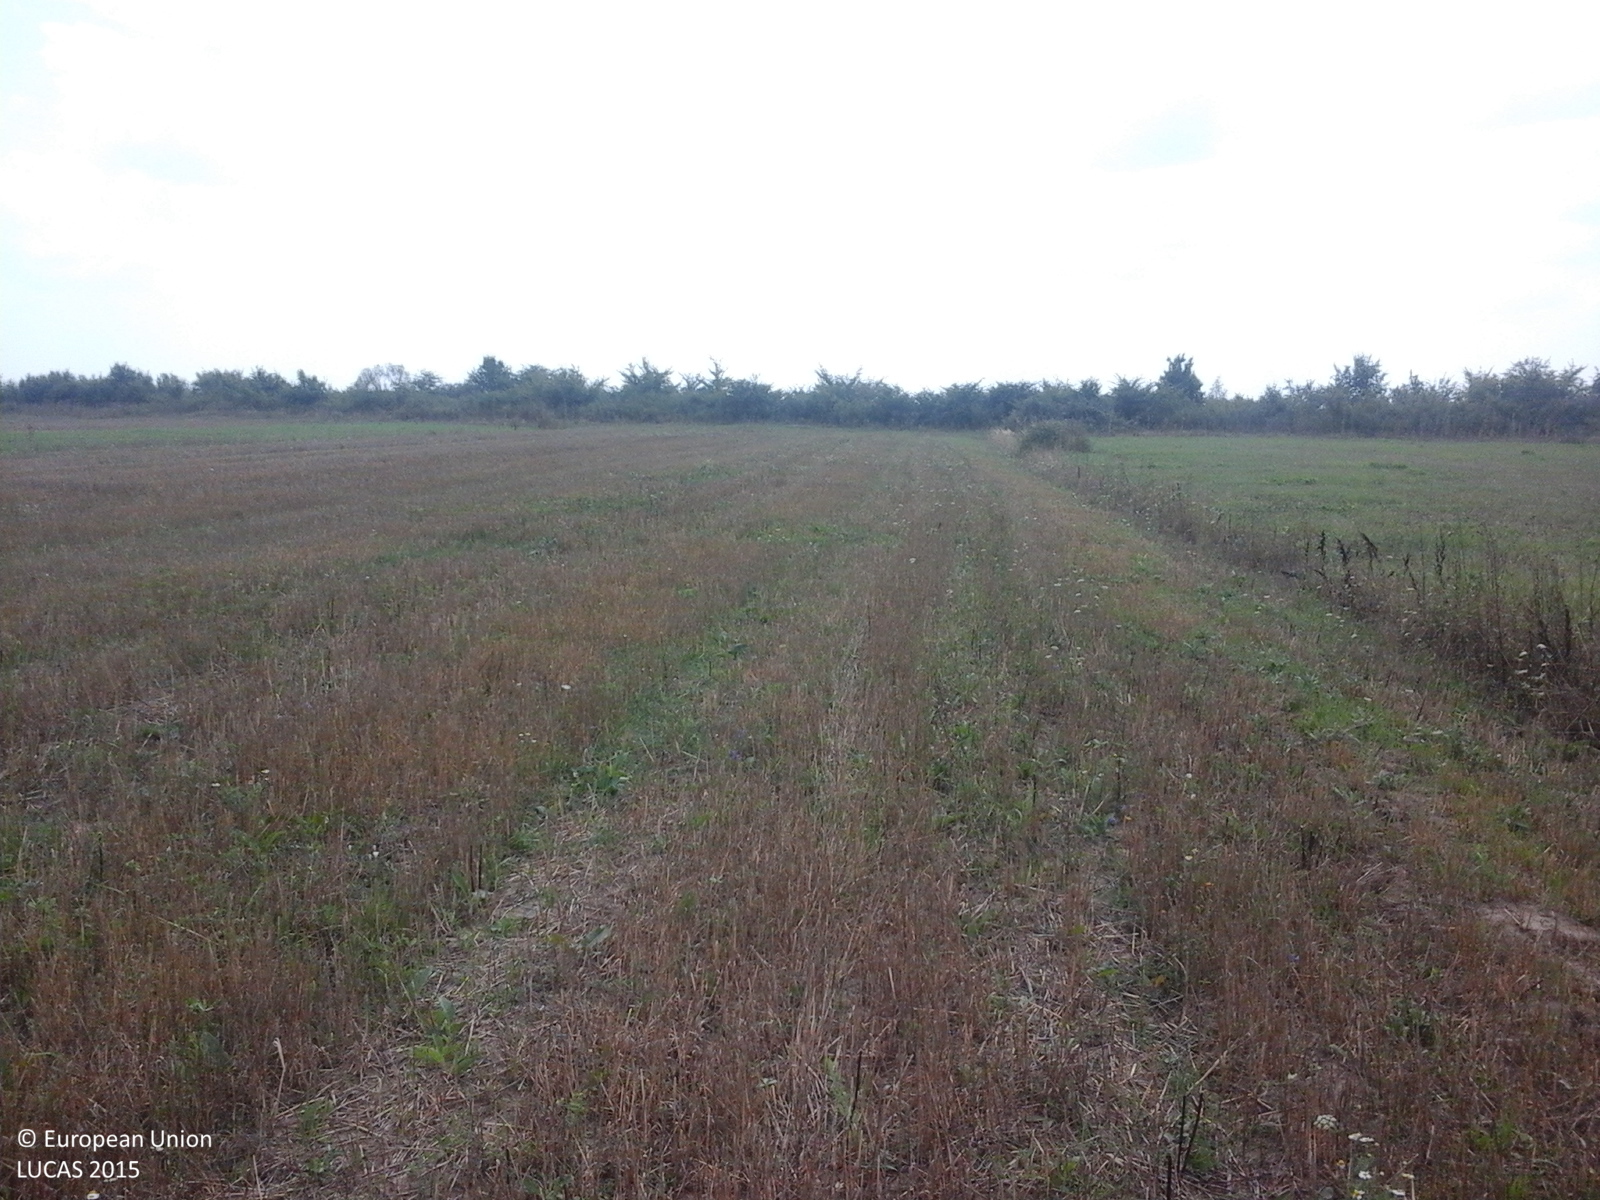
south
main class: Cropland
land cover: Common wheat
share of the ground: 50 - 75 %
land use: Agriculture (excluding fallow land and kitchen gardens)
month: August
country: RO
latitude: 46.6309
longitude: 21.7316
